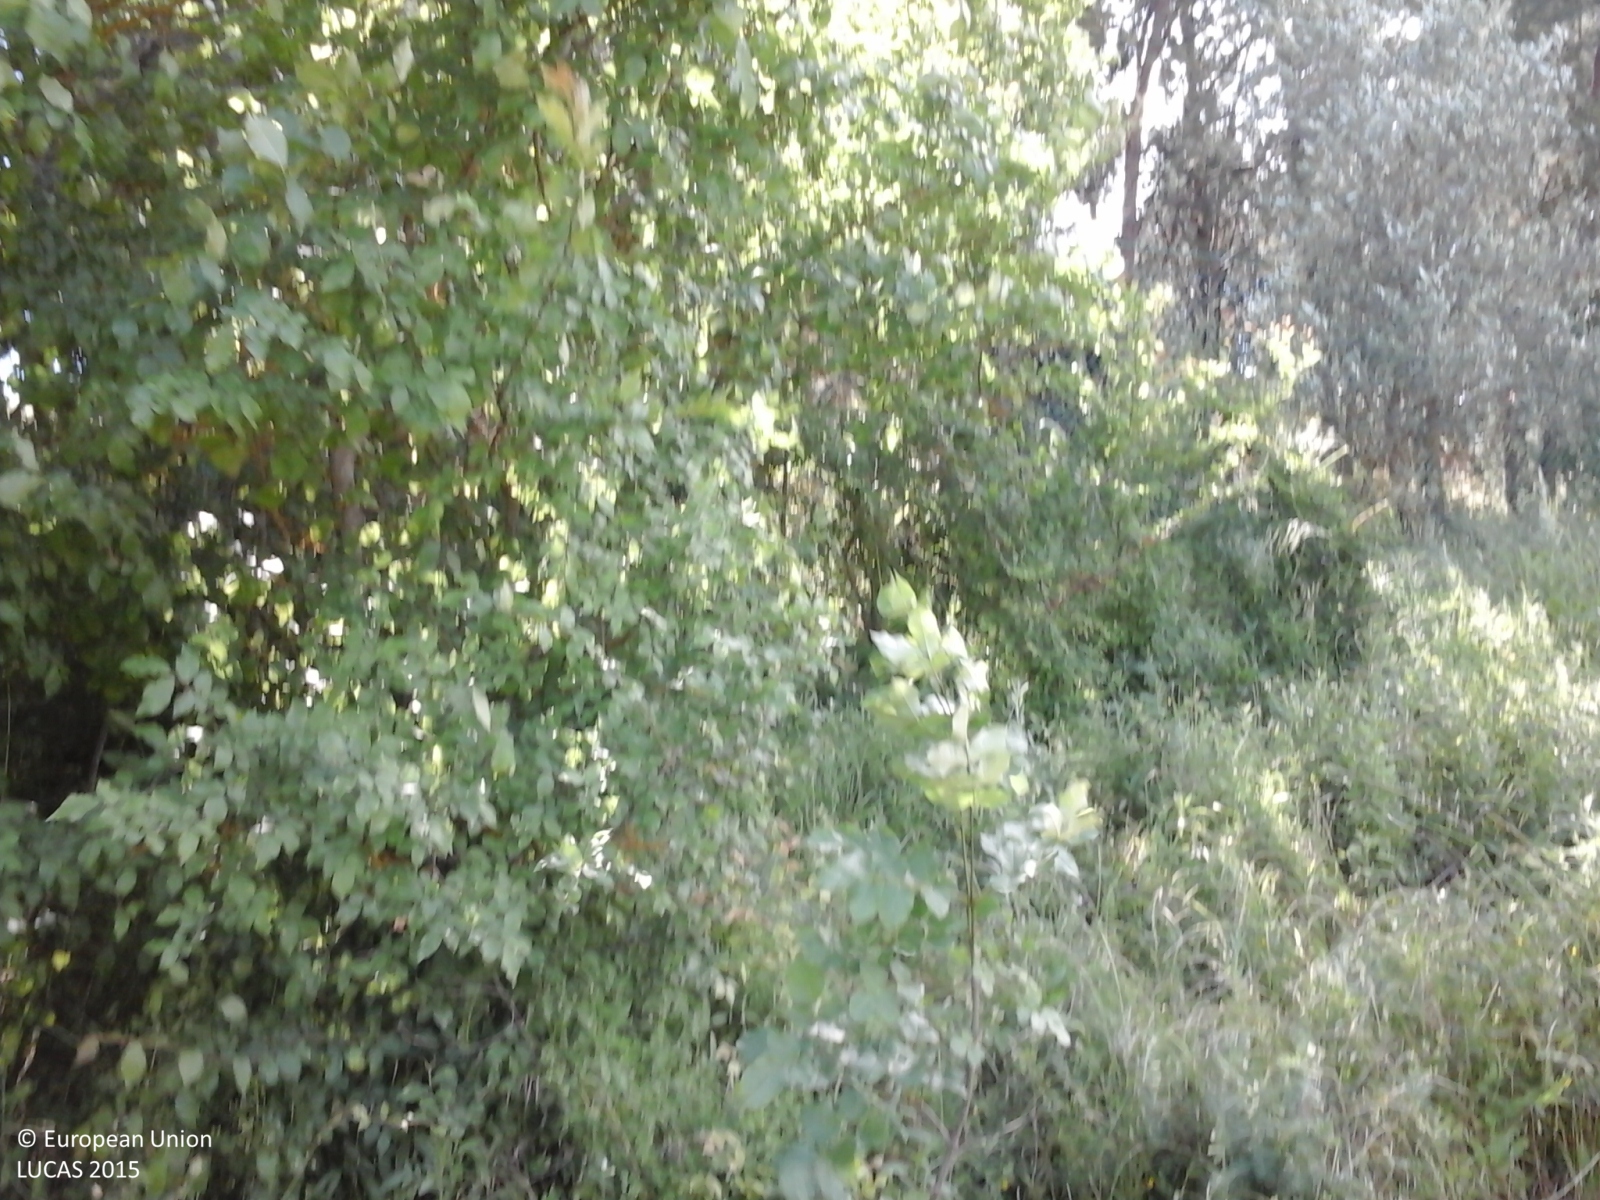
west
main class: Cropland
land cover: Durum wheat
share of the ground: > 75 %
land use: Agriculture (excluding fallow land and kitchen gardens)
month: May
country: IT
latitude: 43.6784
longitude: 10.9773
